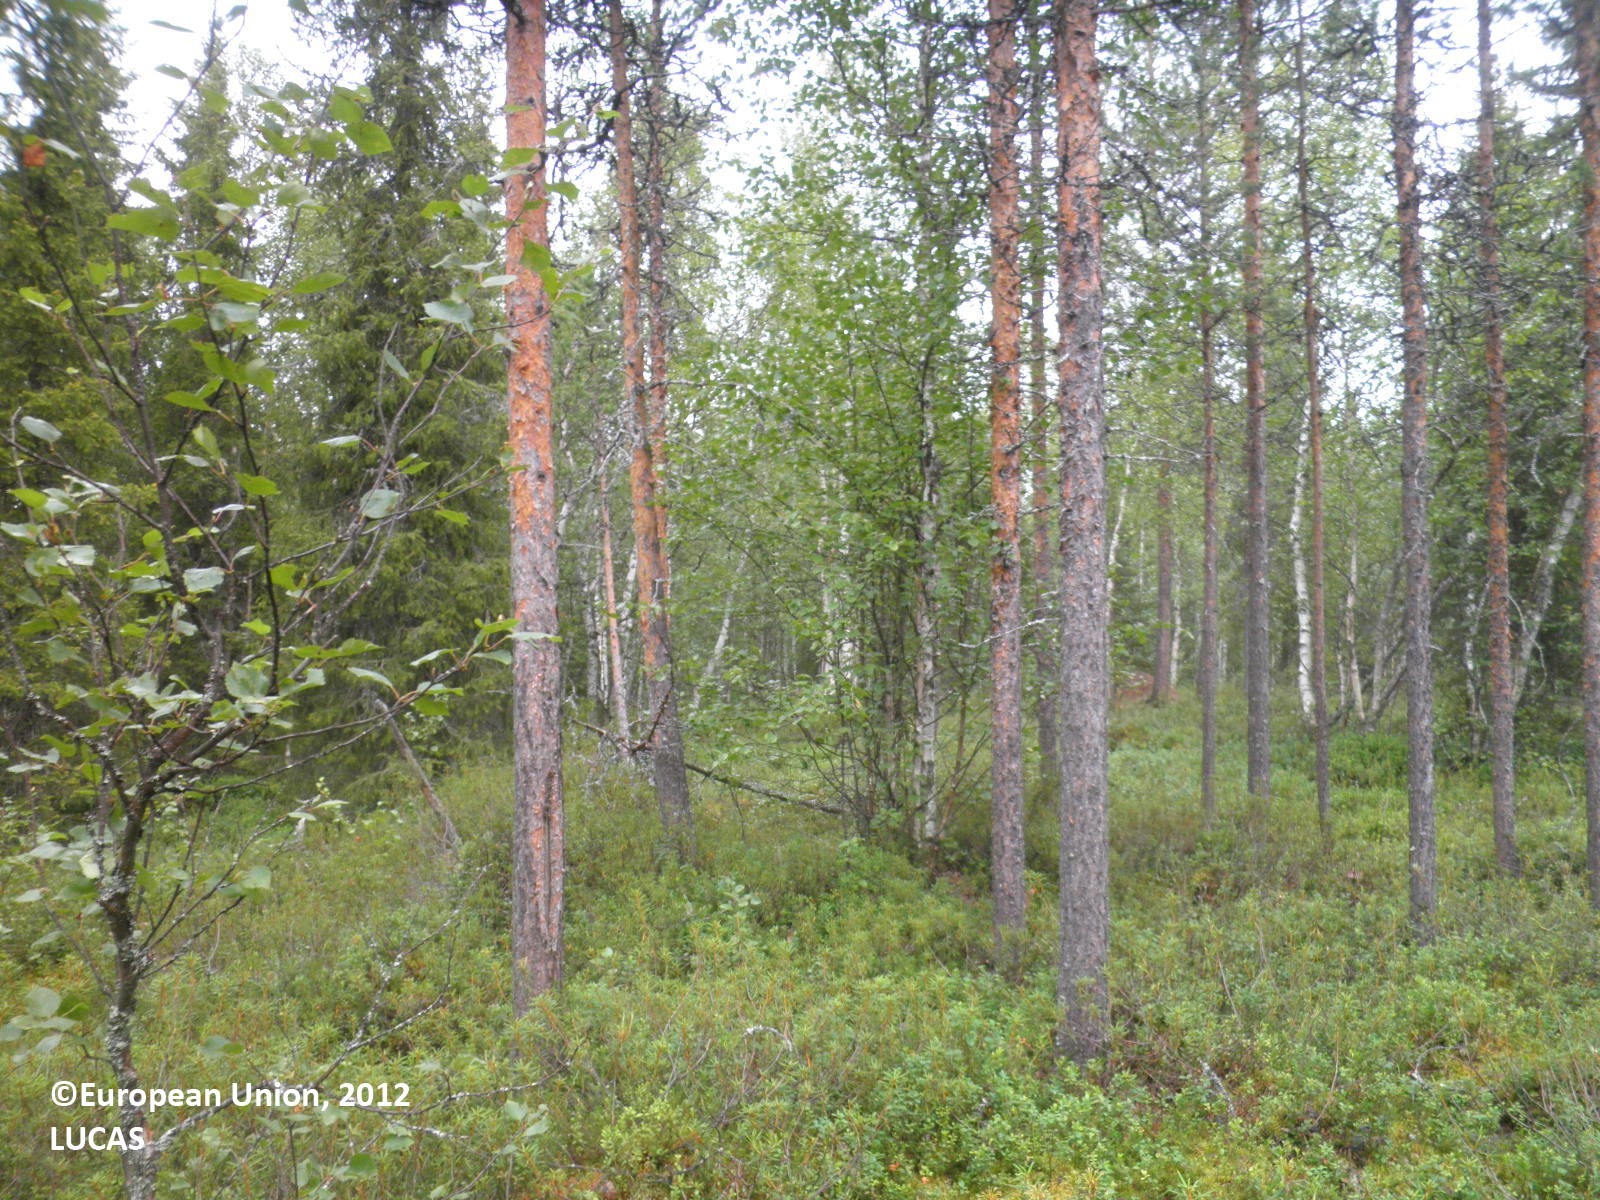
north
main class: Woodland
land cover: Pine dominated mixed woodland
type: boreal forest
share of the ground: 25 - 50 %
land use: Forestry
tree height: > 5 m
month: July
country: FI
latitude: 66.9724
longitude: 28.9142
